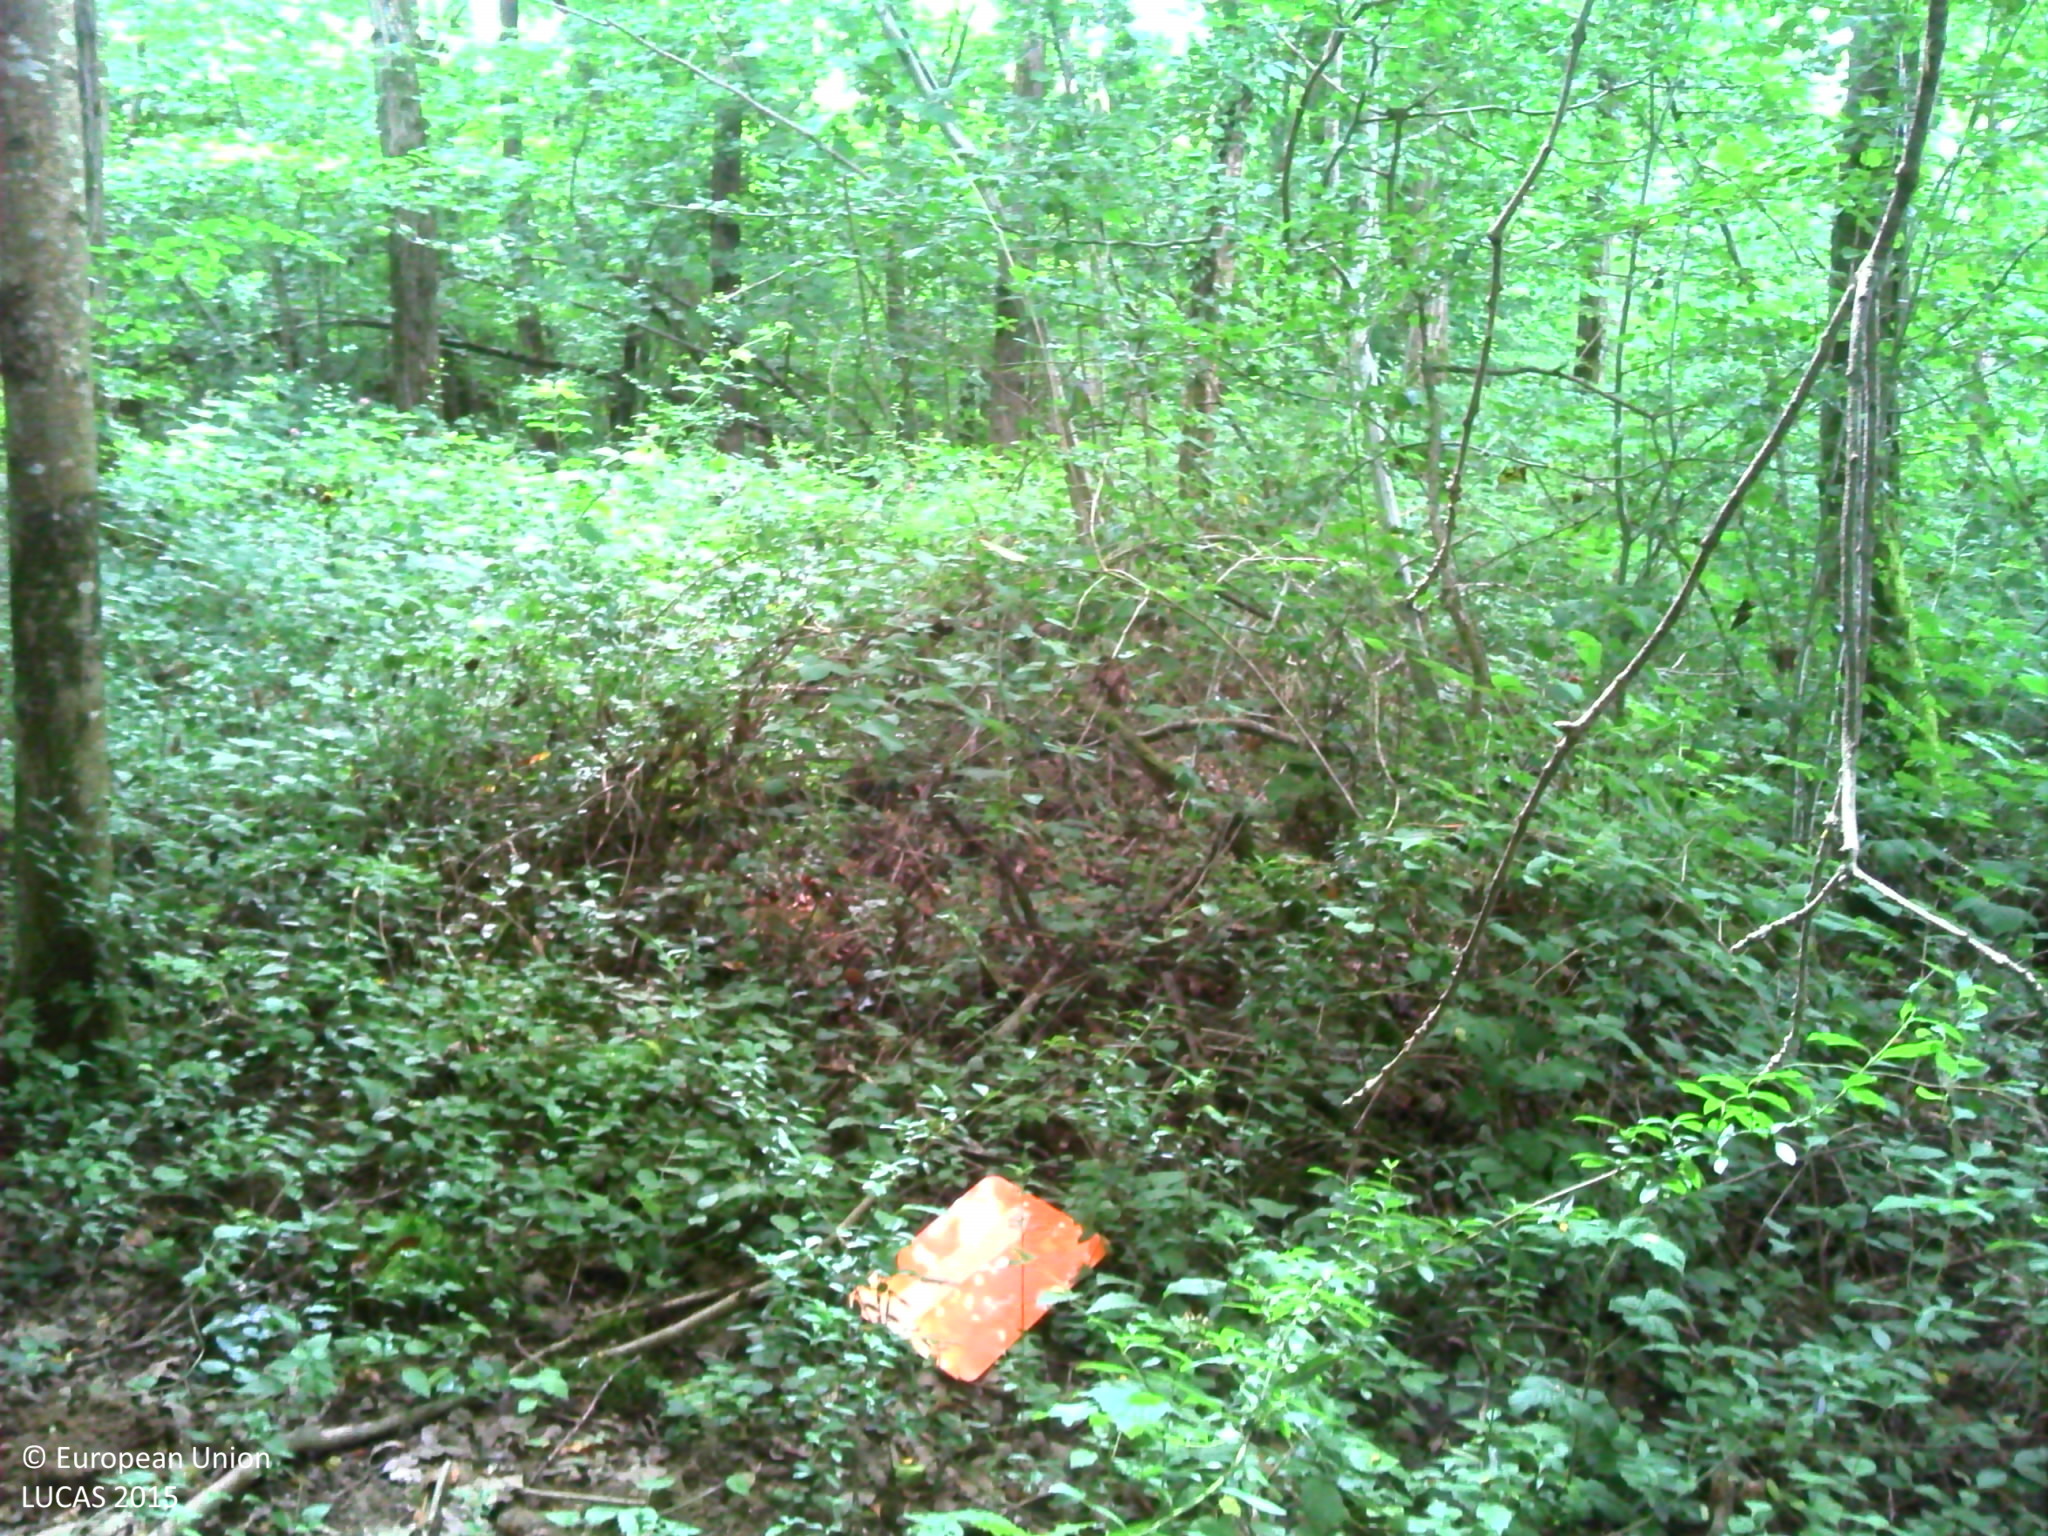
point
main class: Woodland
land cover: Broadleaved woodland
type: mesophytic deciduous forest
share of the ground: > 75 %
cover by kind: broadleaved forest trees 85 %, shrubs 10 %, herbaceous plants 5 %
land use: Forestry
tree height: > 5 m
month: June
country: FR
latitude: 46.7565
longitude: 5.3806
